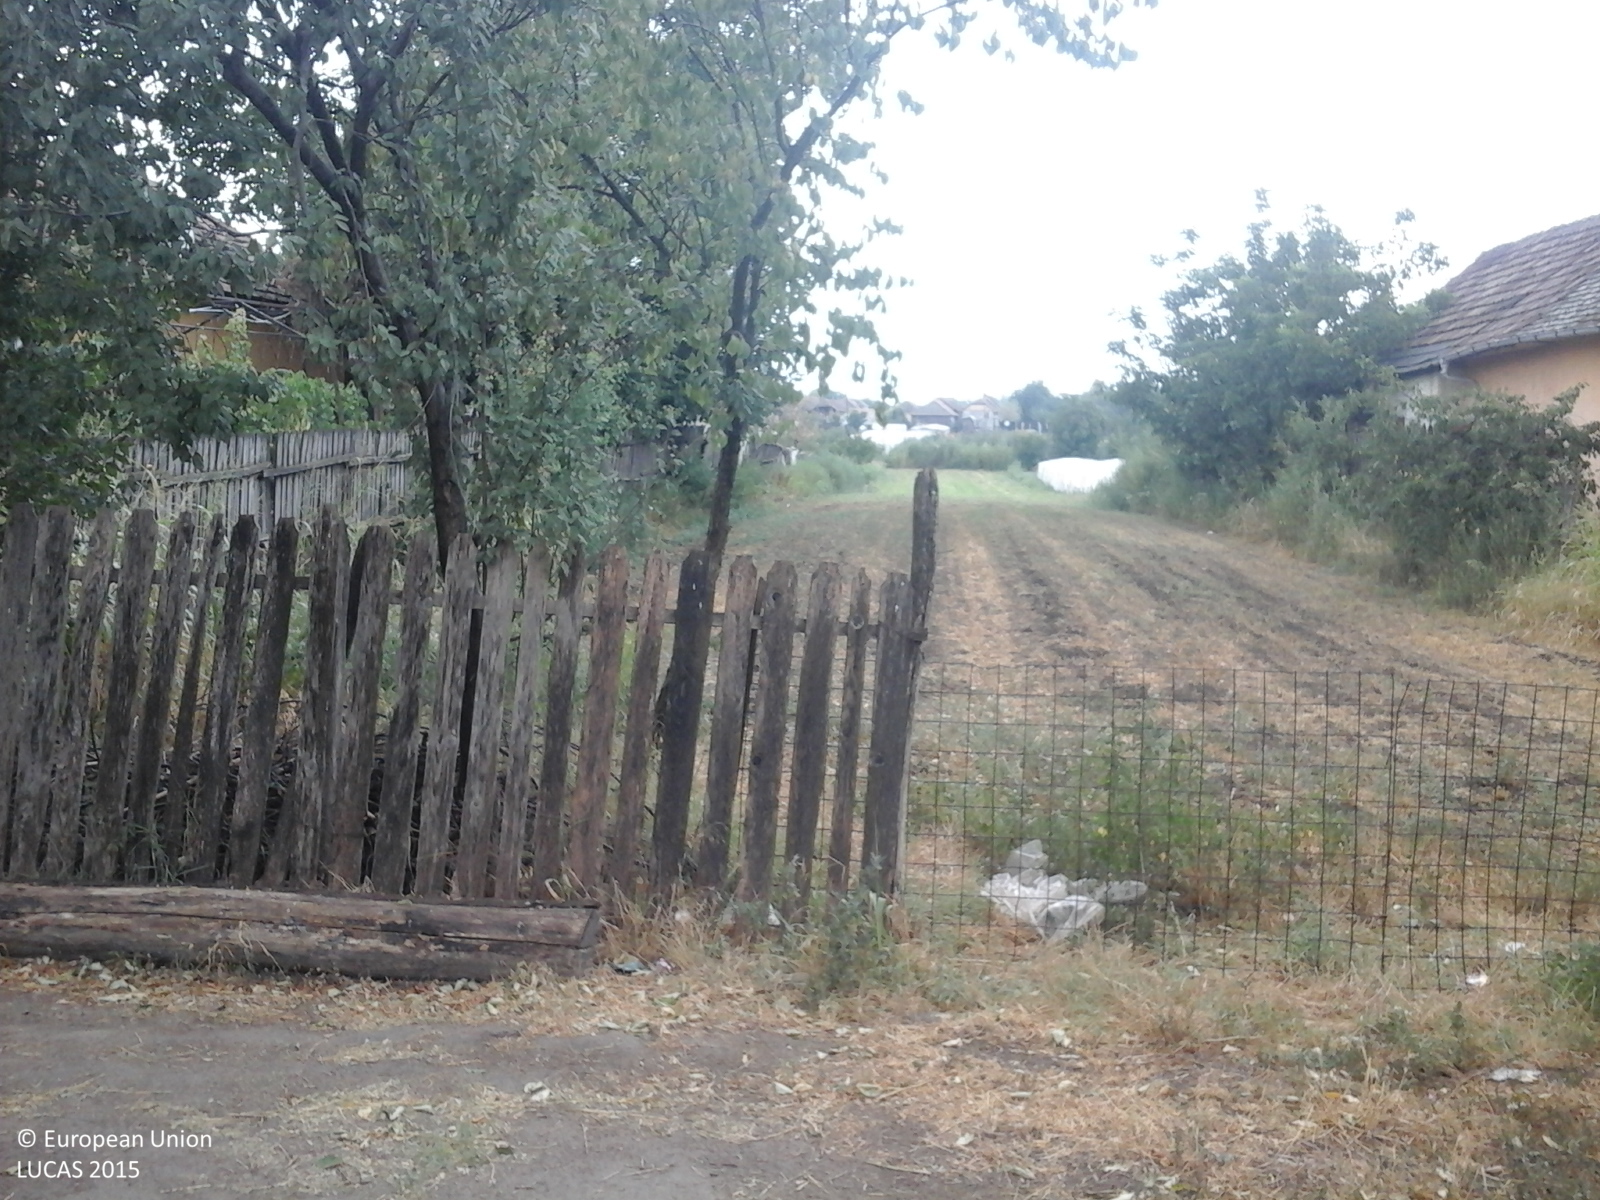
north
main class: Cropland
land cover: Other leguminous and mixtures for fodder
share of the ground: > 75 %
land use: Kitchen garden
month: August
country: RO
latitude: 43.9263
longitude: 23.0324
